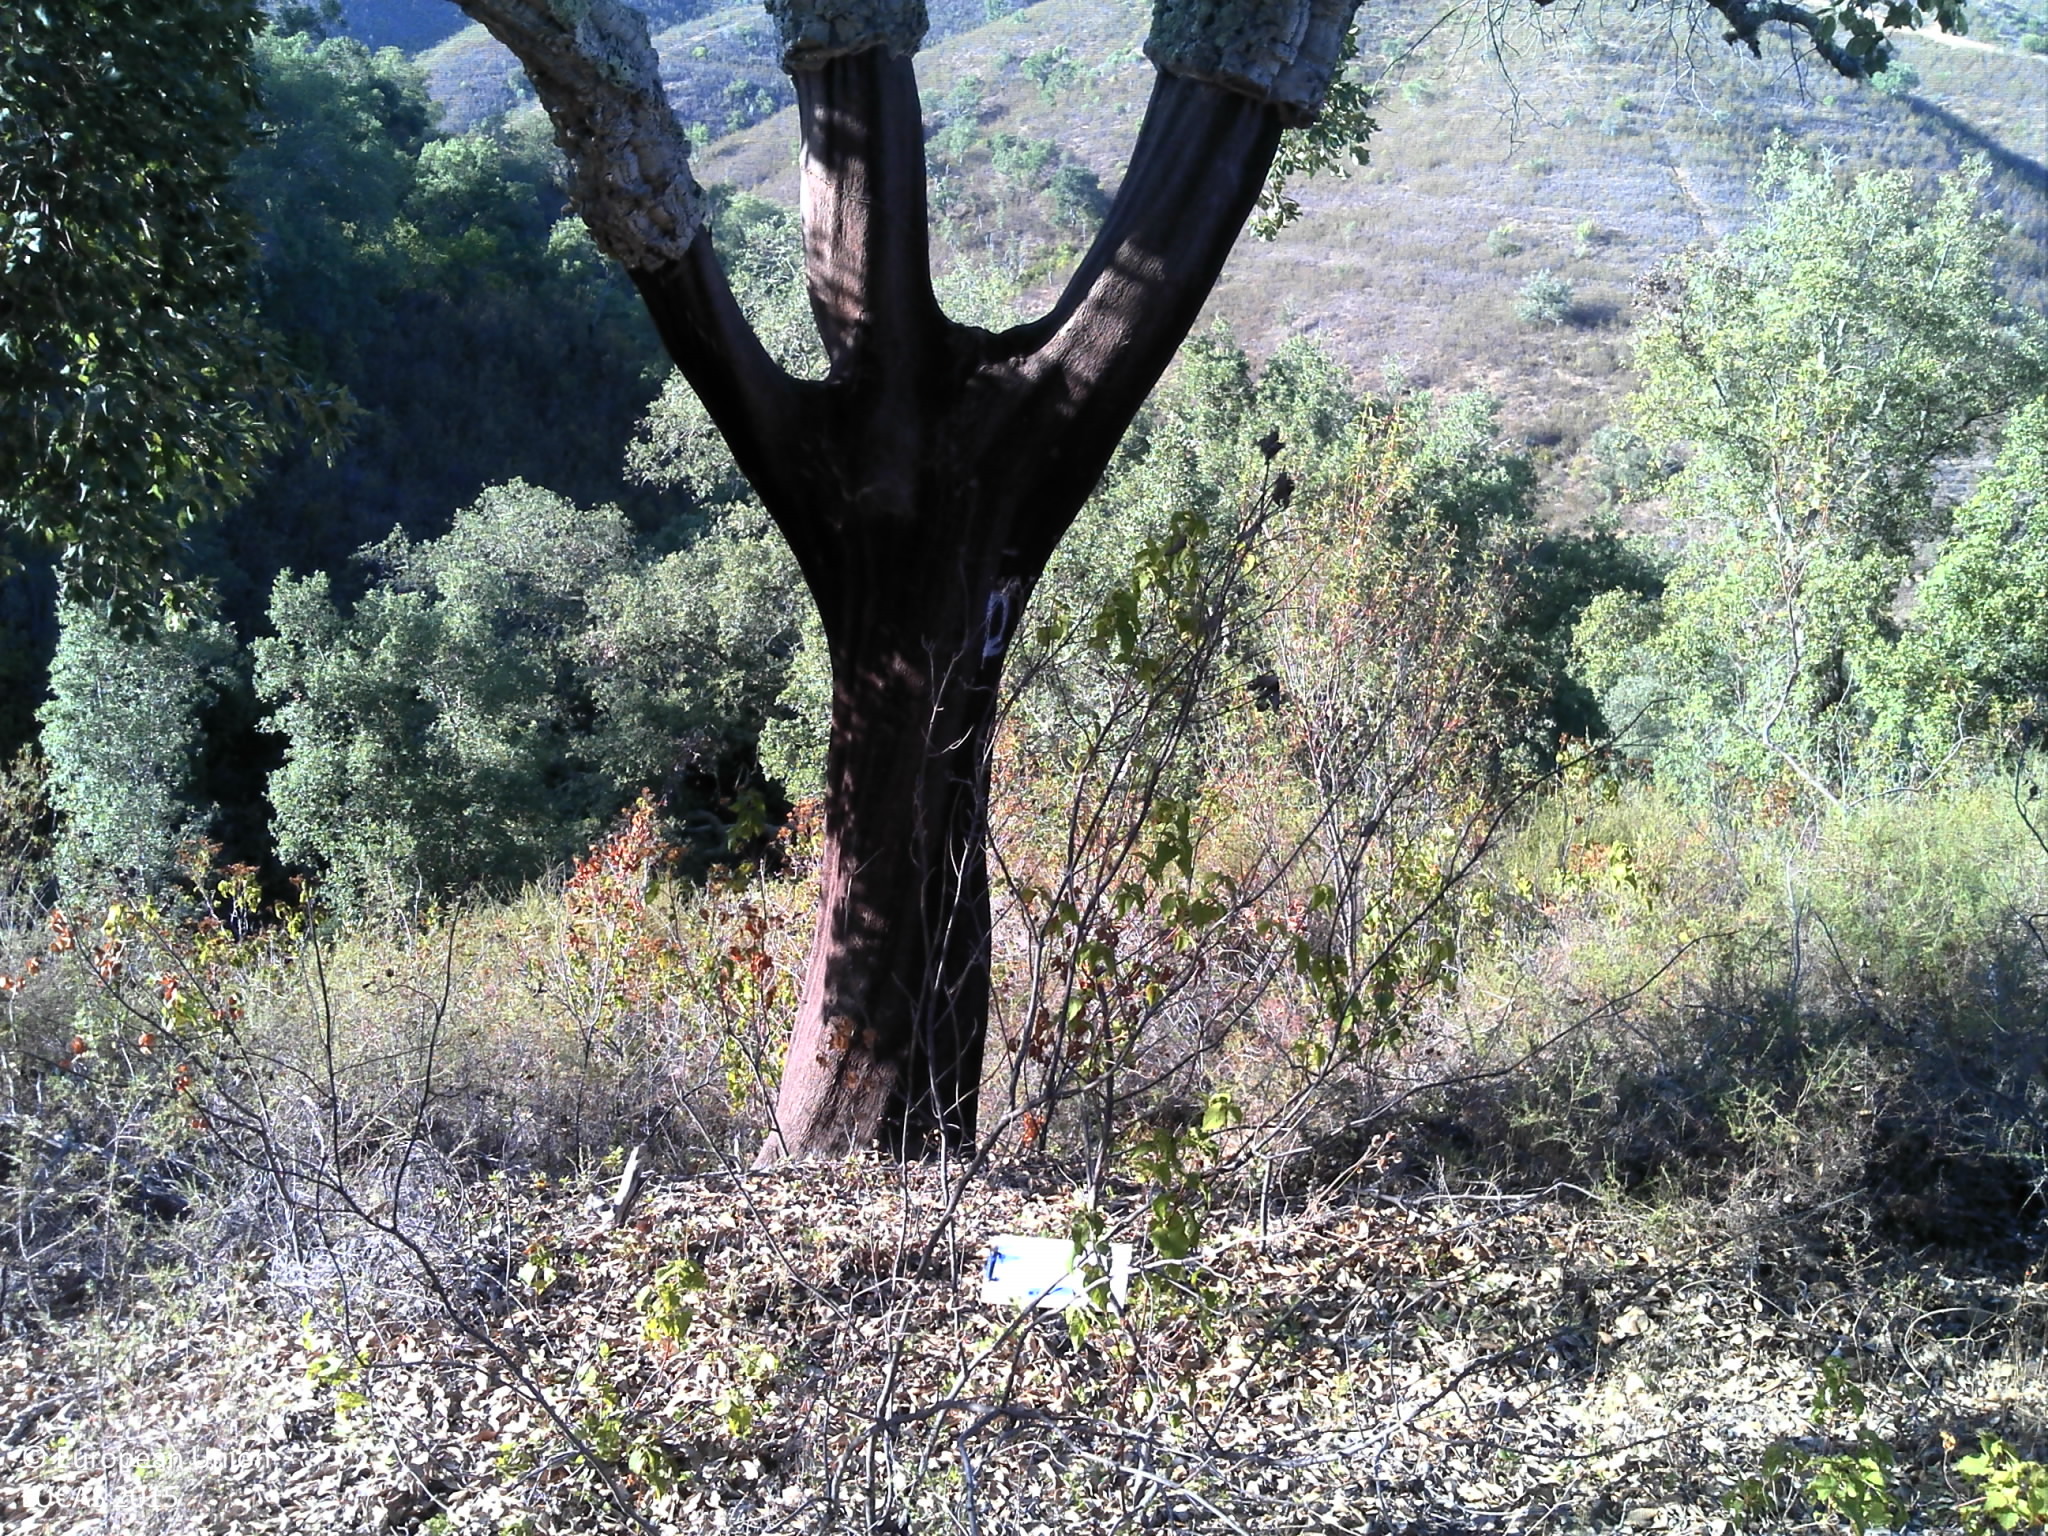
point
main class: Woodland
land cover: Broadleaved woodland
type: broadleaved evergreen forest
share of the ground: 25 - 50 %
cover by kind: broadleaved forest trees 40 %, shrubs 40 %, herbaceous plants 10 %, unconsolidated bare surface 10 %
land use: Forestry
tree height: > 5 m
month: September
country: PT
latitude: 37.4282
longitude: -8.2529
